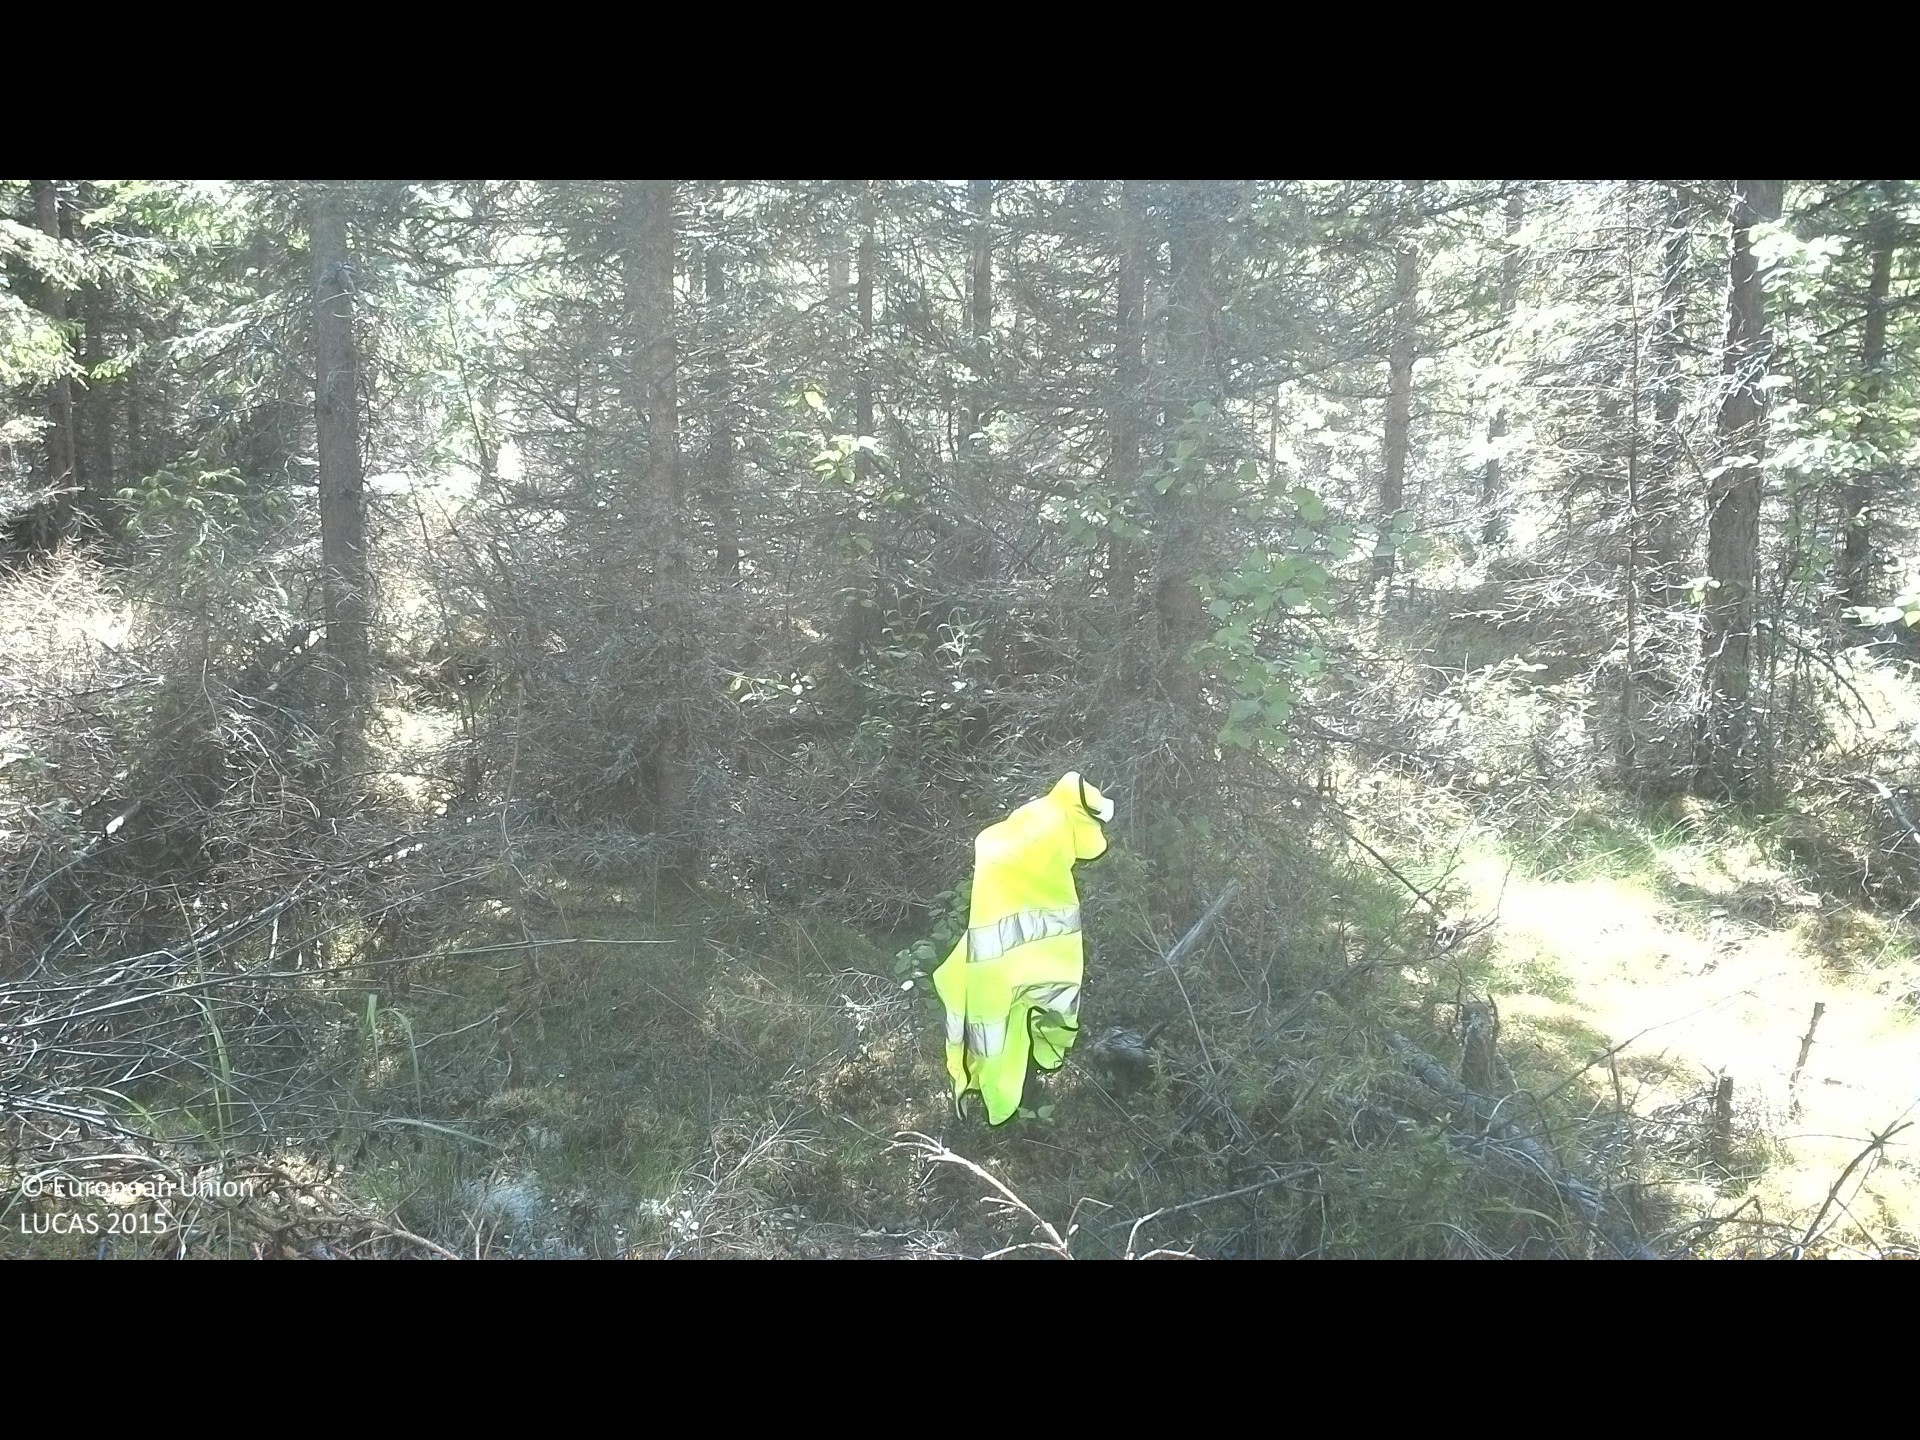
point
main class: Woodland
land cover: Spruce dominated coniferous woodland
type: boreal forest
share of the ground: 25 - 50 %
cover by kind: lichens and mosses 65 %, coniferous forest trees 35 %
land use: Forestry
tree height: > 5 m
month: June
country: SE
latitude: 62.0764
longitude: 16.0109
